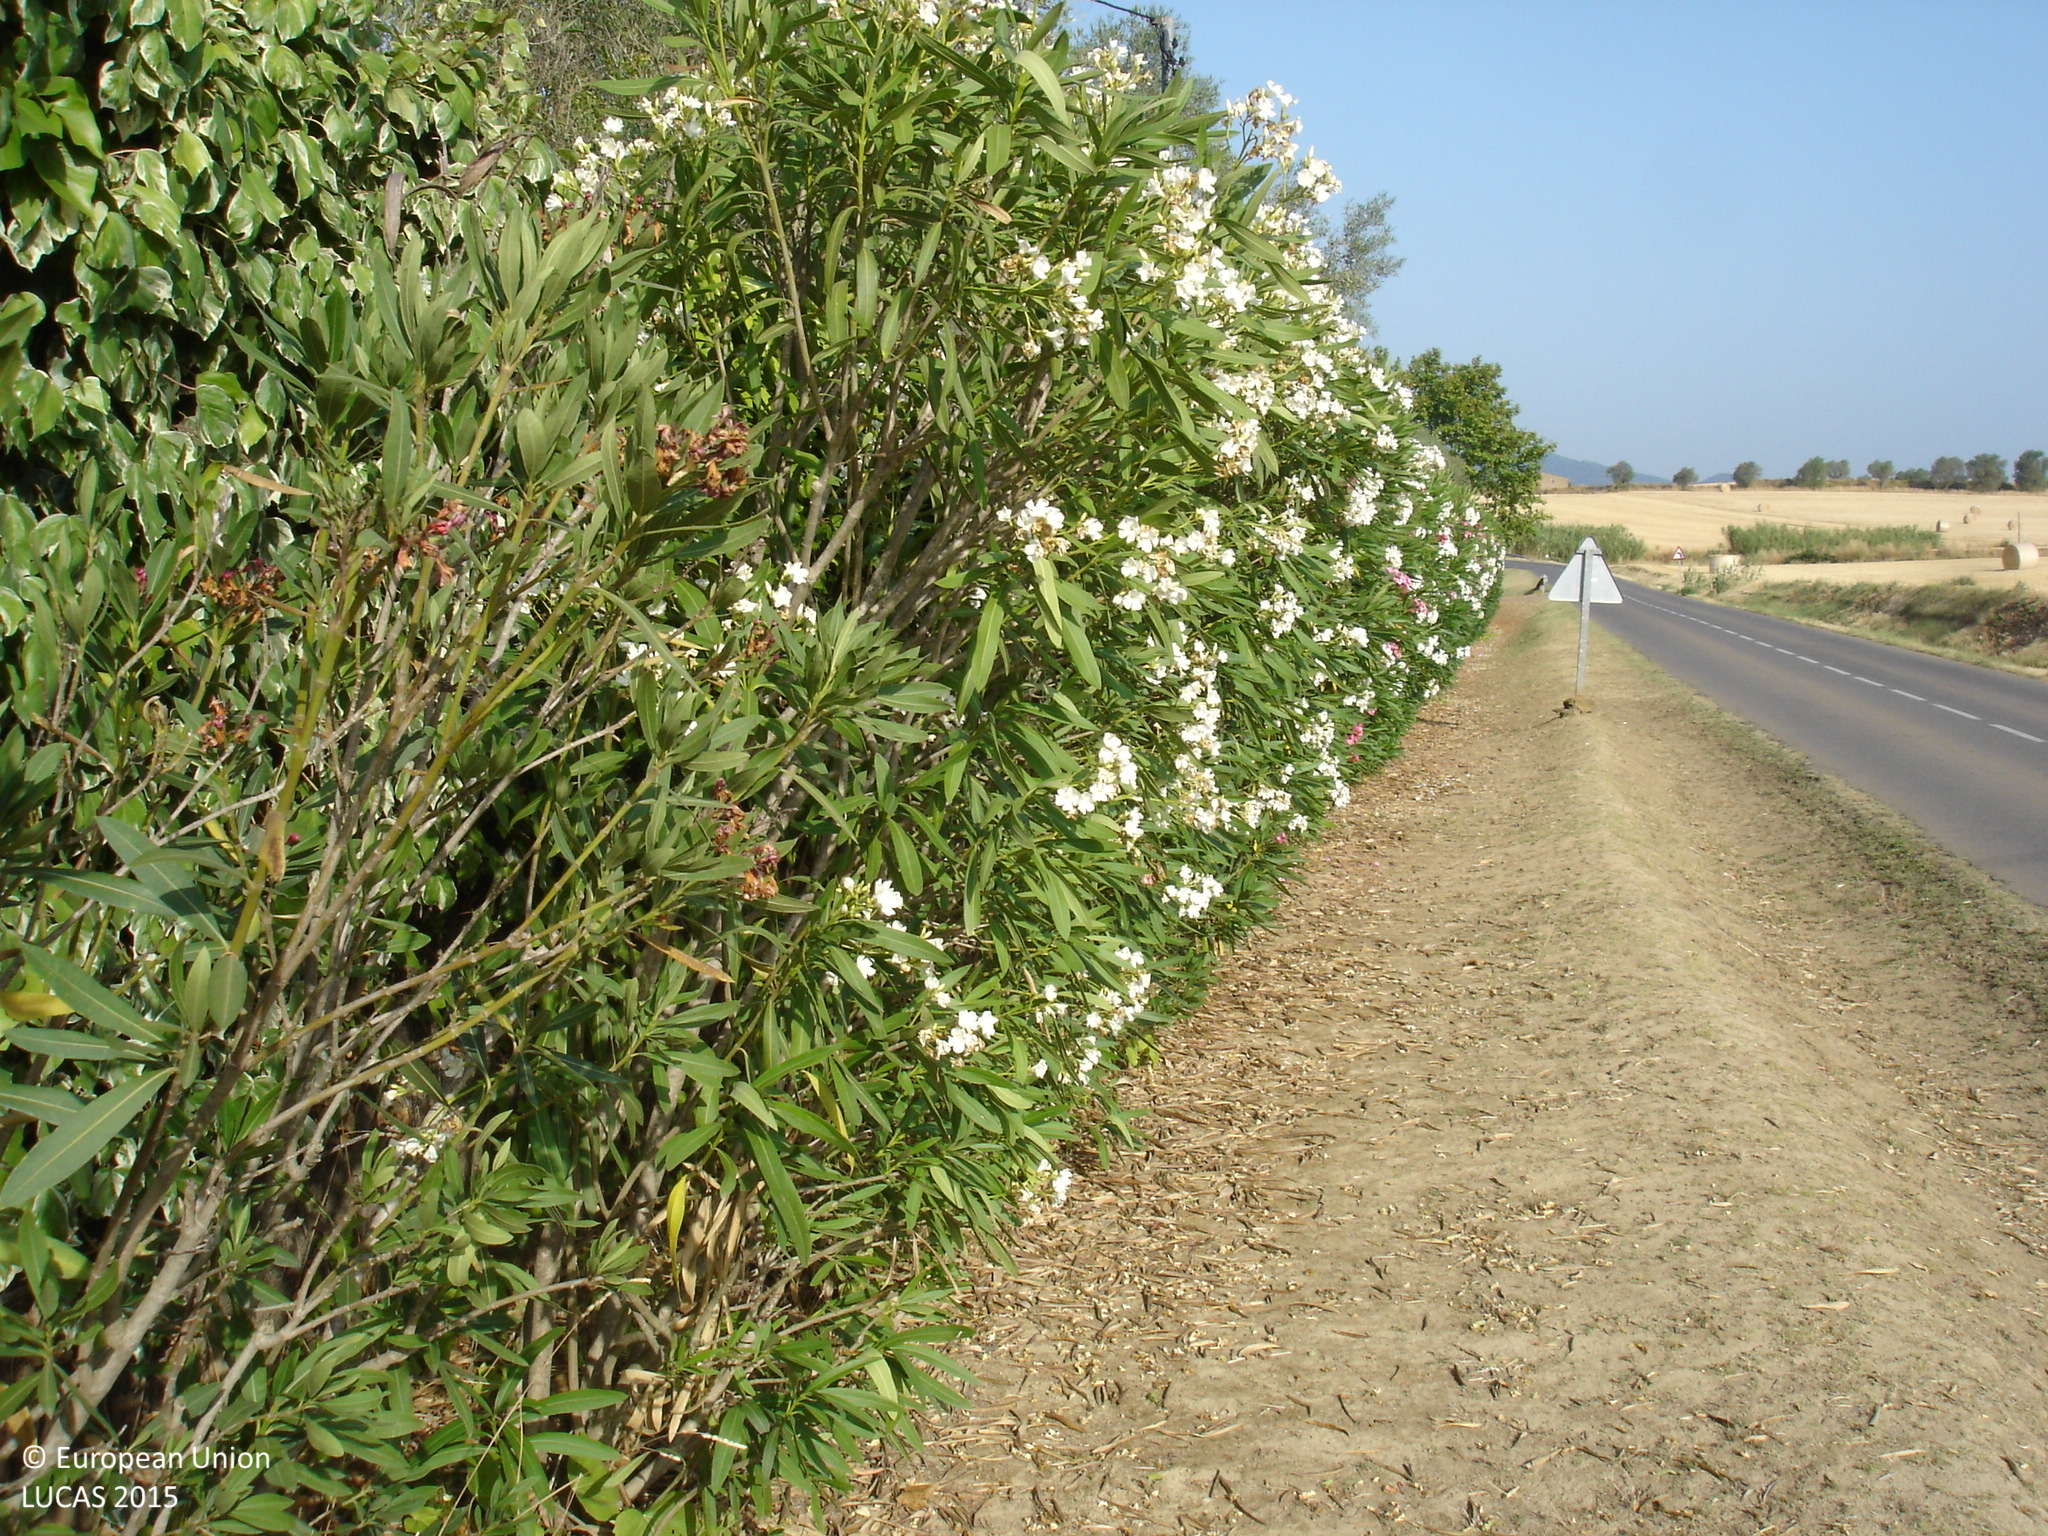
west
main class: Cropland
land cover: Olive groves
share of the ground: 25 - 50 %
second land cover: Other bare soil
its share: > 75 %
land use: Agriculture (excluding fallow land and kitchen gardens)
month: July
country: ES
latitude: 41.9590
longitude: 3.0061
